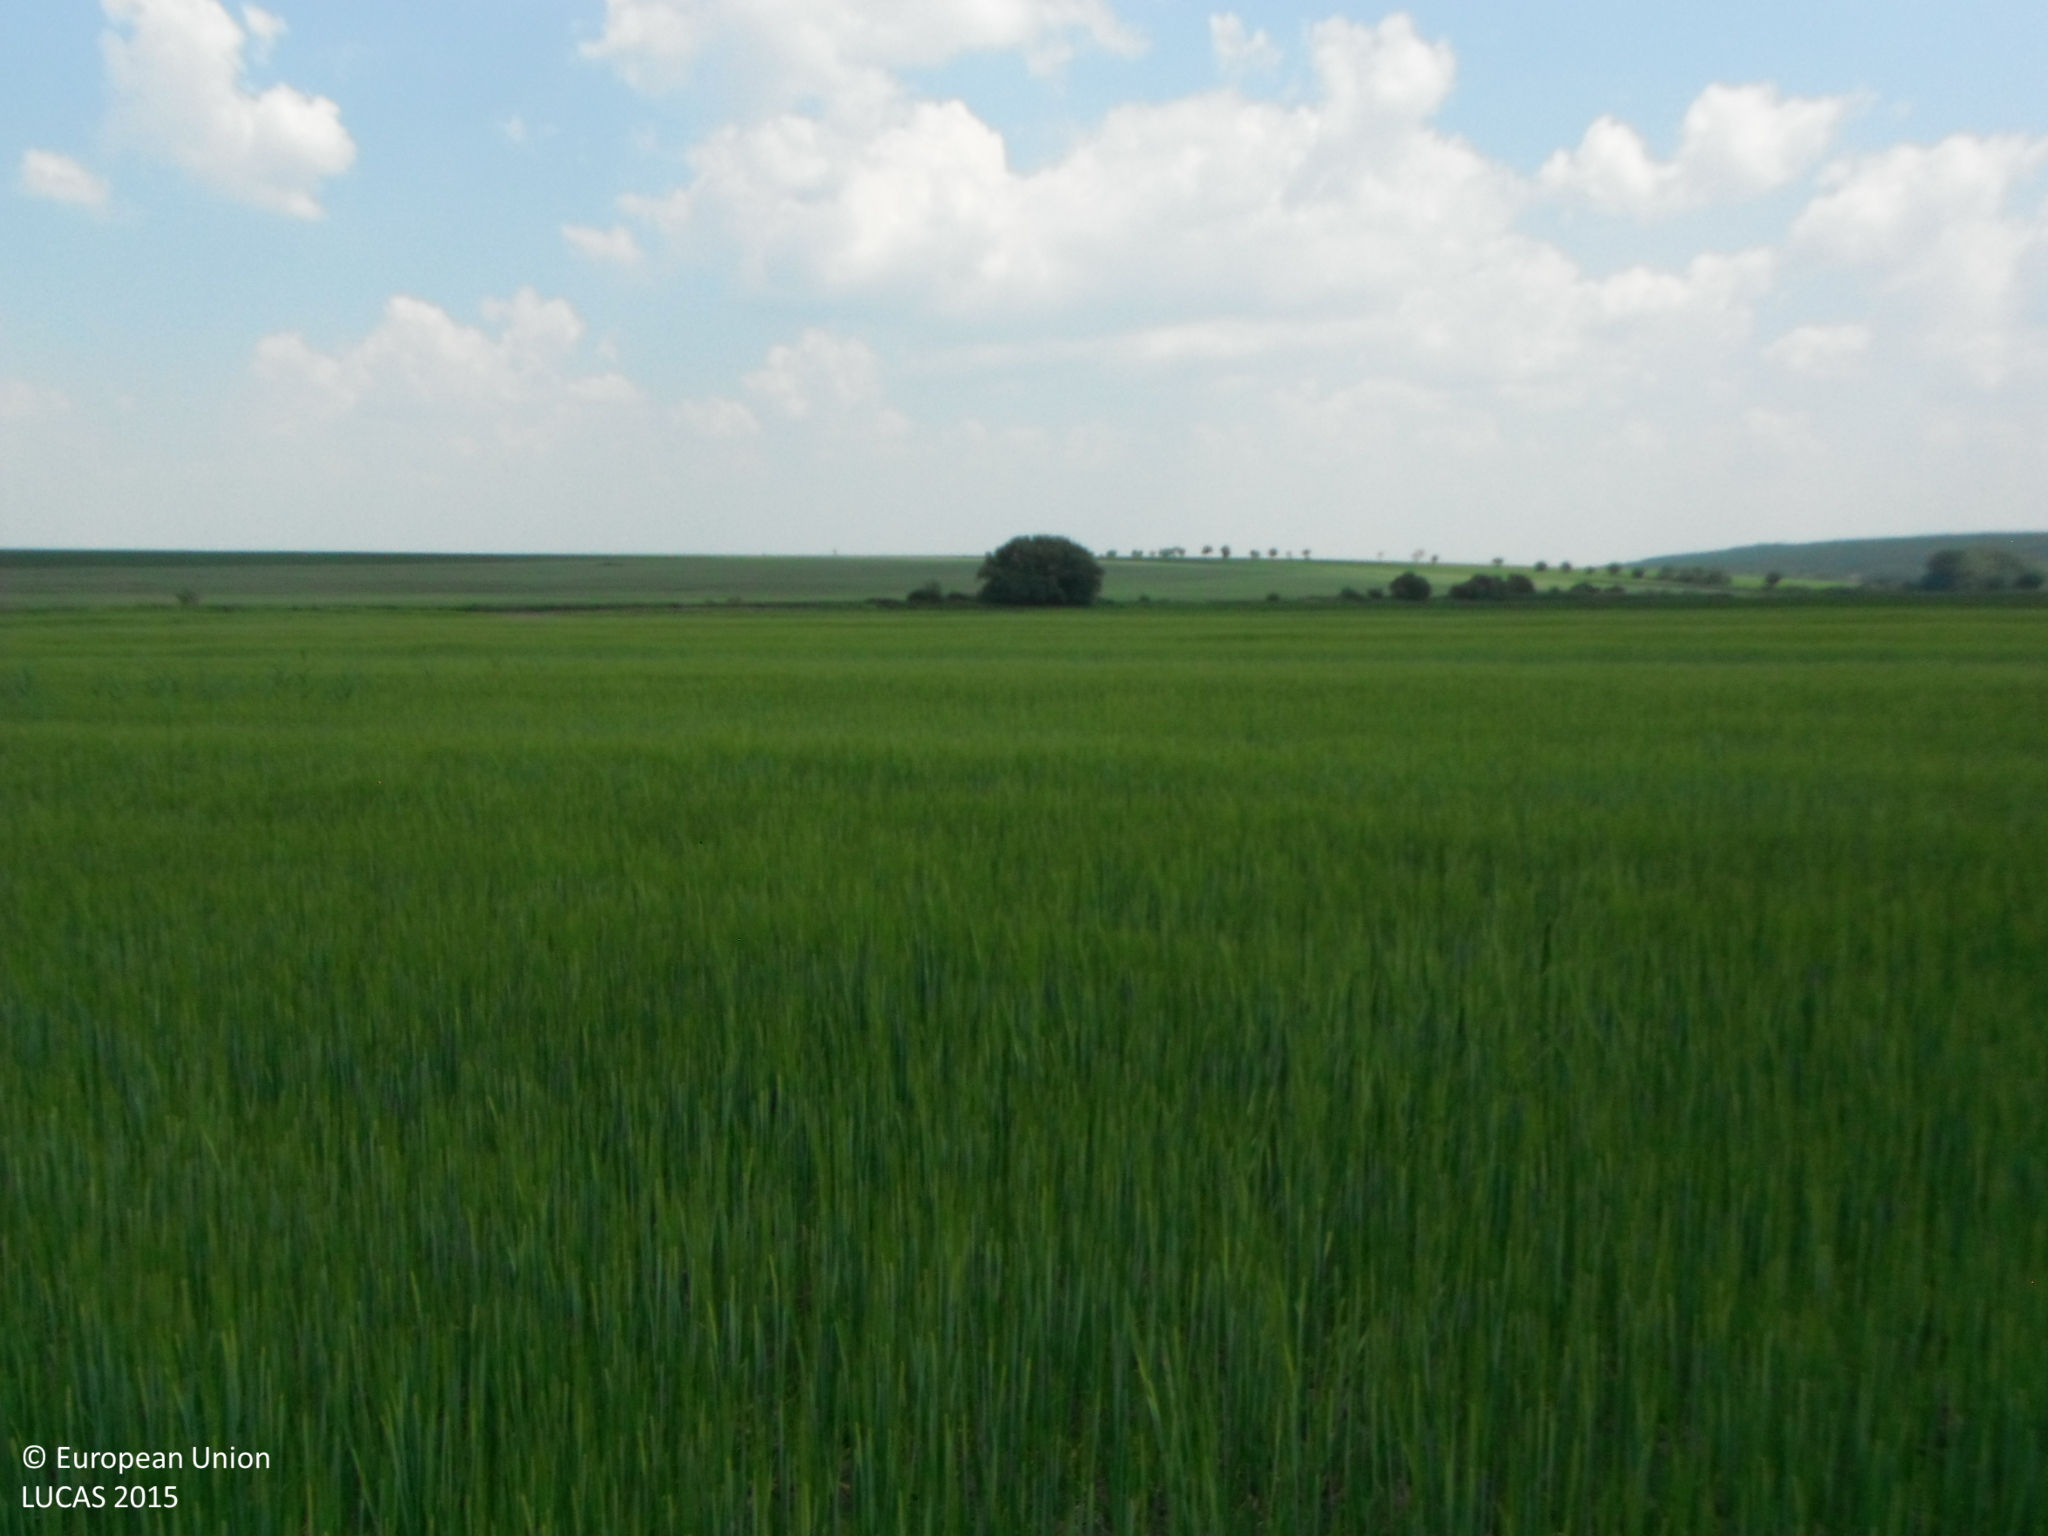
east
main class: Cropland
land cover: Barley
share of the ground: > 75 %
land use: Agriculture (excluding fallow land and kitchen gardens)
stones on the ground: < 10 %
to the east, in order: Barley; Maize; Shruby margins; Ditches and canals; Shruby margins; Common wheat
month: June
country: SK
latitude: 48.4244
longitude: 17.4291
